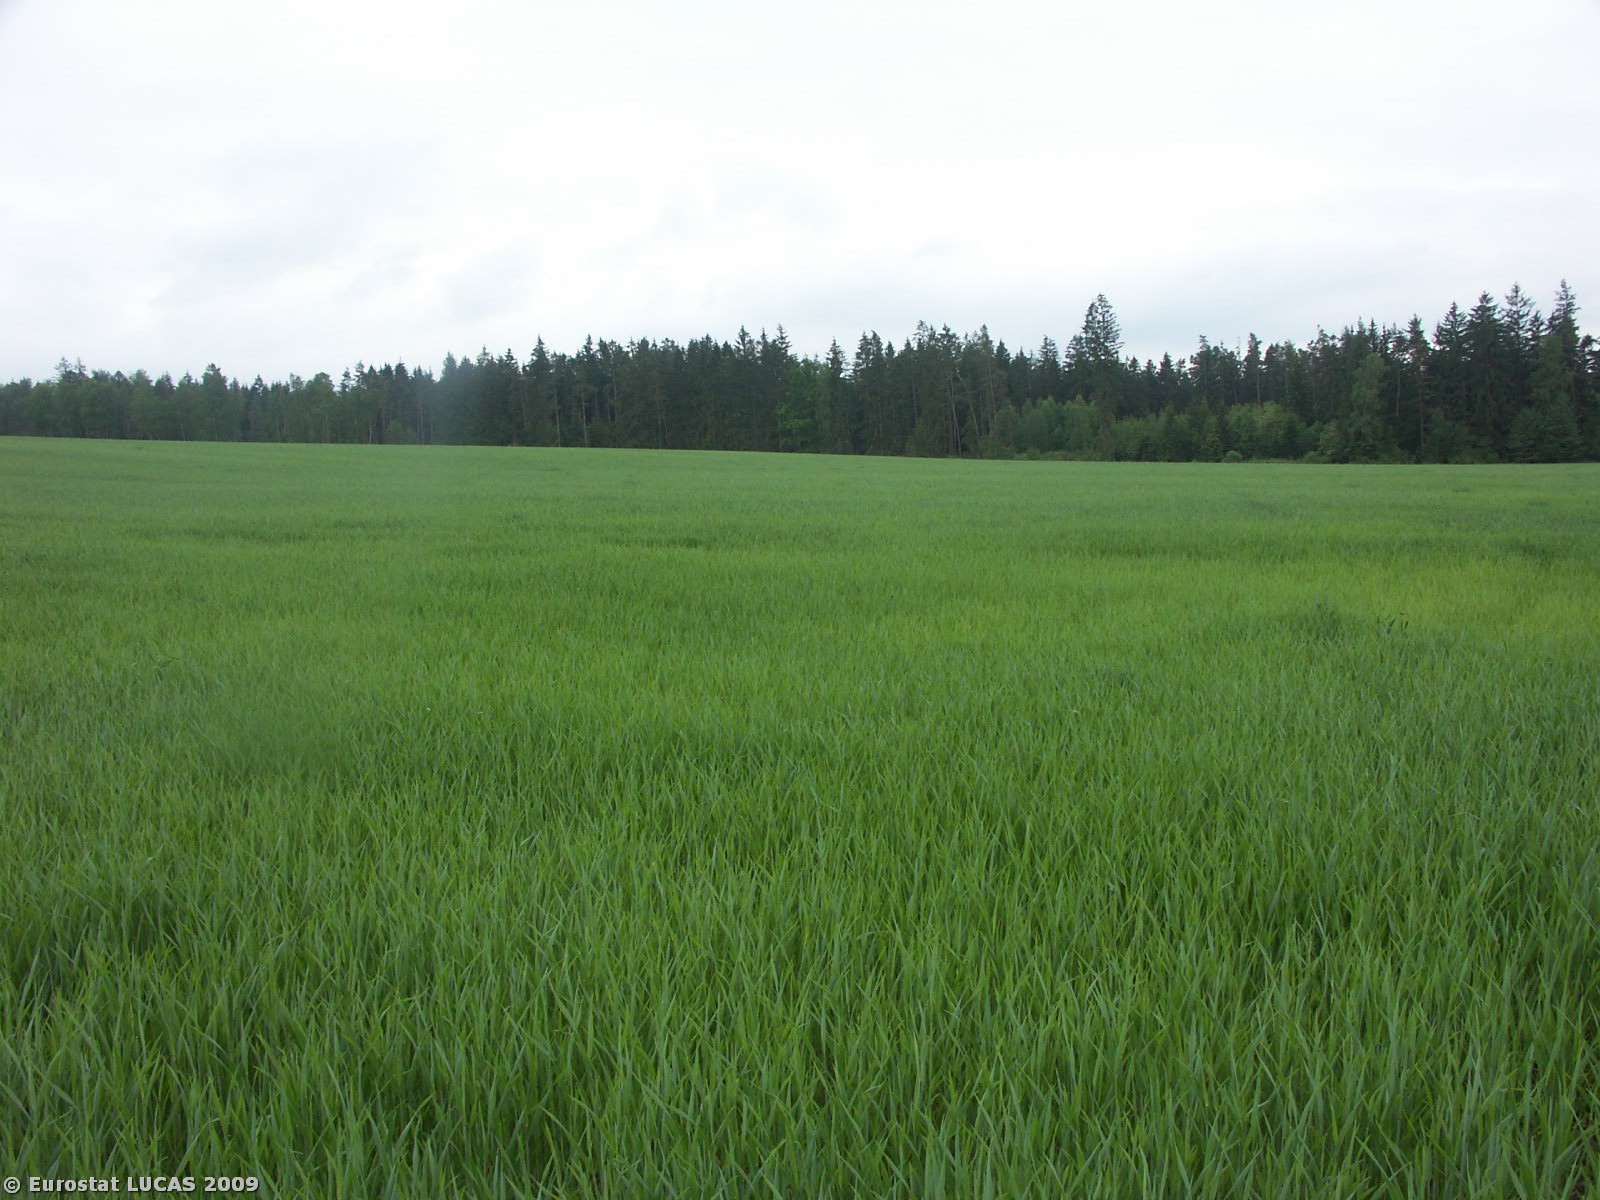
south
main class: Cropland
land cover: Common wheat
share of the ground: > 75 %
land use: Agriculture (excluding fallow land and kitchen gardens)
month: May
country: CZ
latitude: 49.1601
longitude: 14.8976
